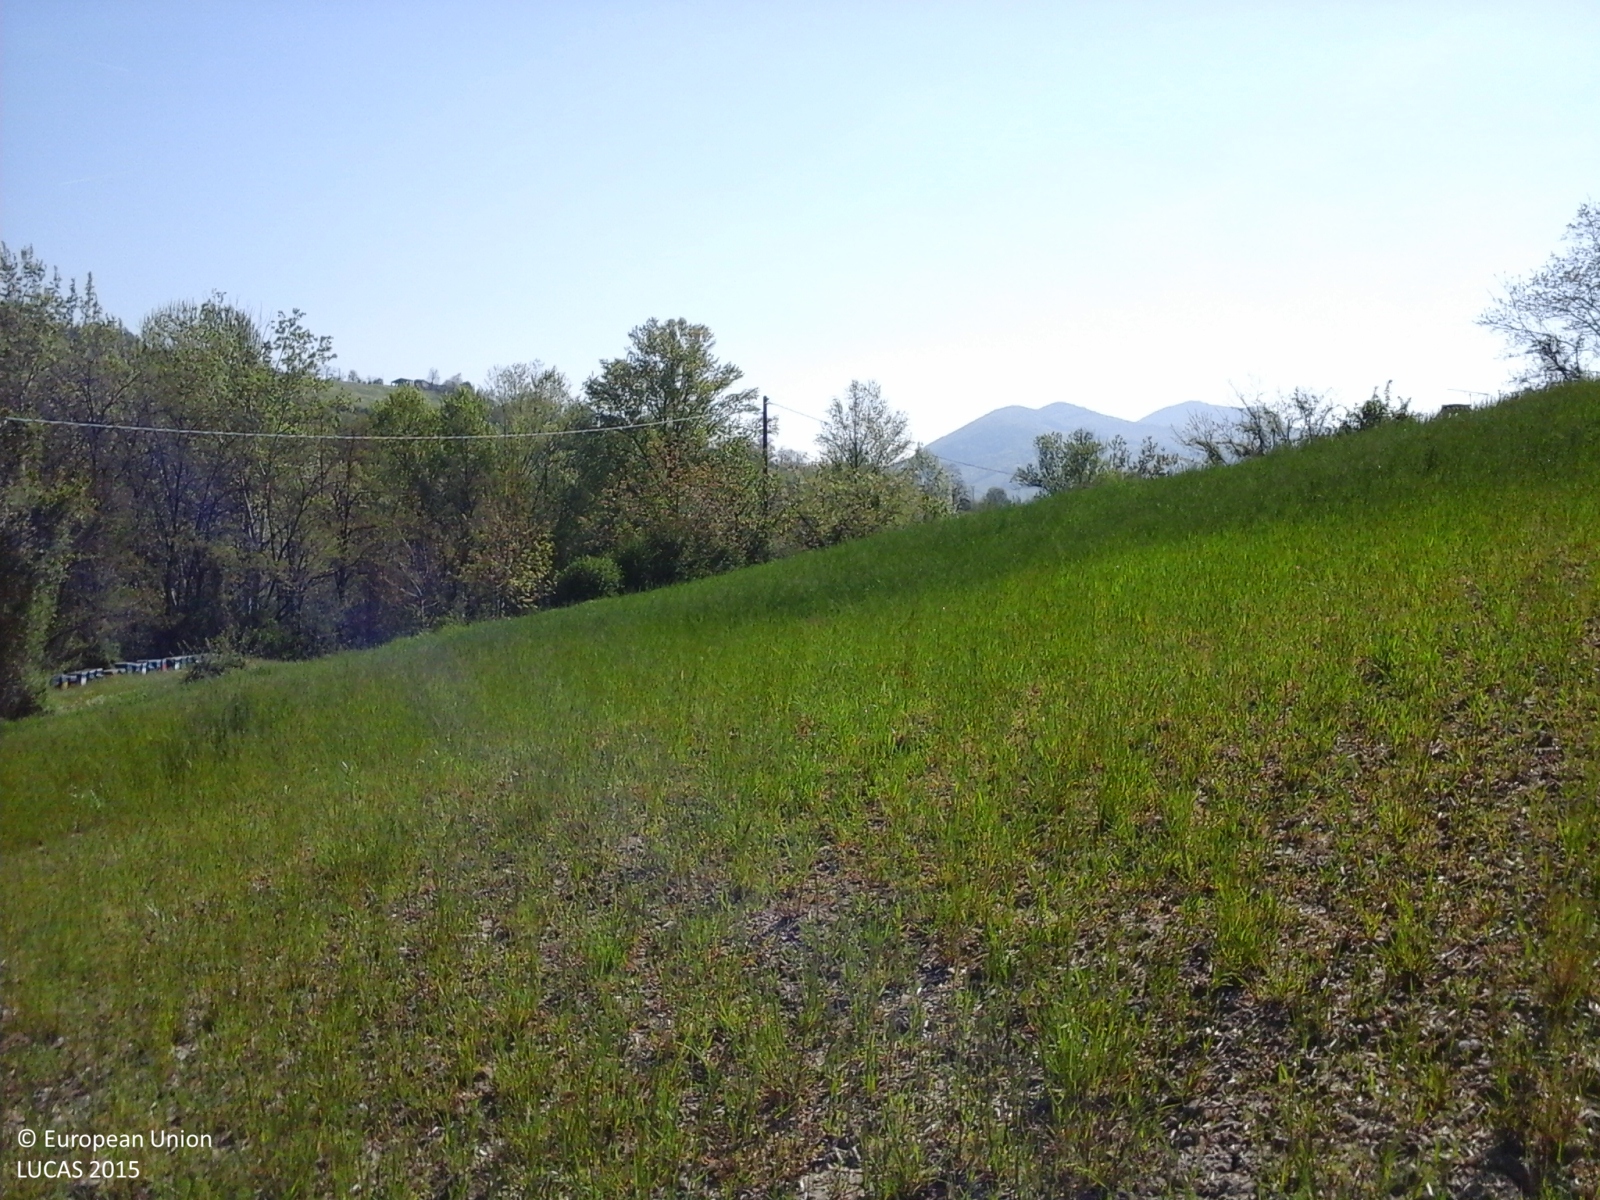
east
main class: Grassland
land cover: Spontaneously vegetated surfaces
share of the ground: 10 - 25 %
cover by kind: herbaceous plants 80 %, unconsolidated bare surface 20 %
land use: Agriculture (excluding fallow land and kitchen gardens)
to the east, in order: Spontaneously vegetated surfaces; Common wheat; Managed hedges; Electric lines; Grassland without tree/shrub cover; Ditches and canals; Tracks; Fences; Grassland without tree/shrub cover; Tracks; Broadleaved woodland; Inland fresh running water; Broadleaved woodland; Electric lines; Paved roads, cycling and walking lanes
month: April
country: IT
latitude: 44.9072
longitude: 9.3048
